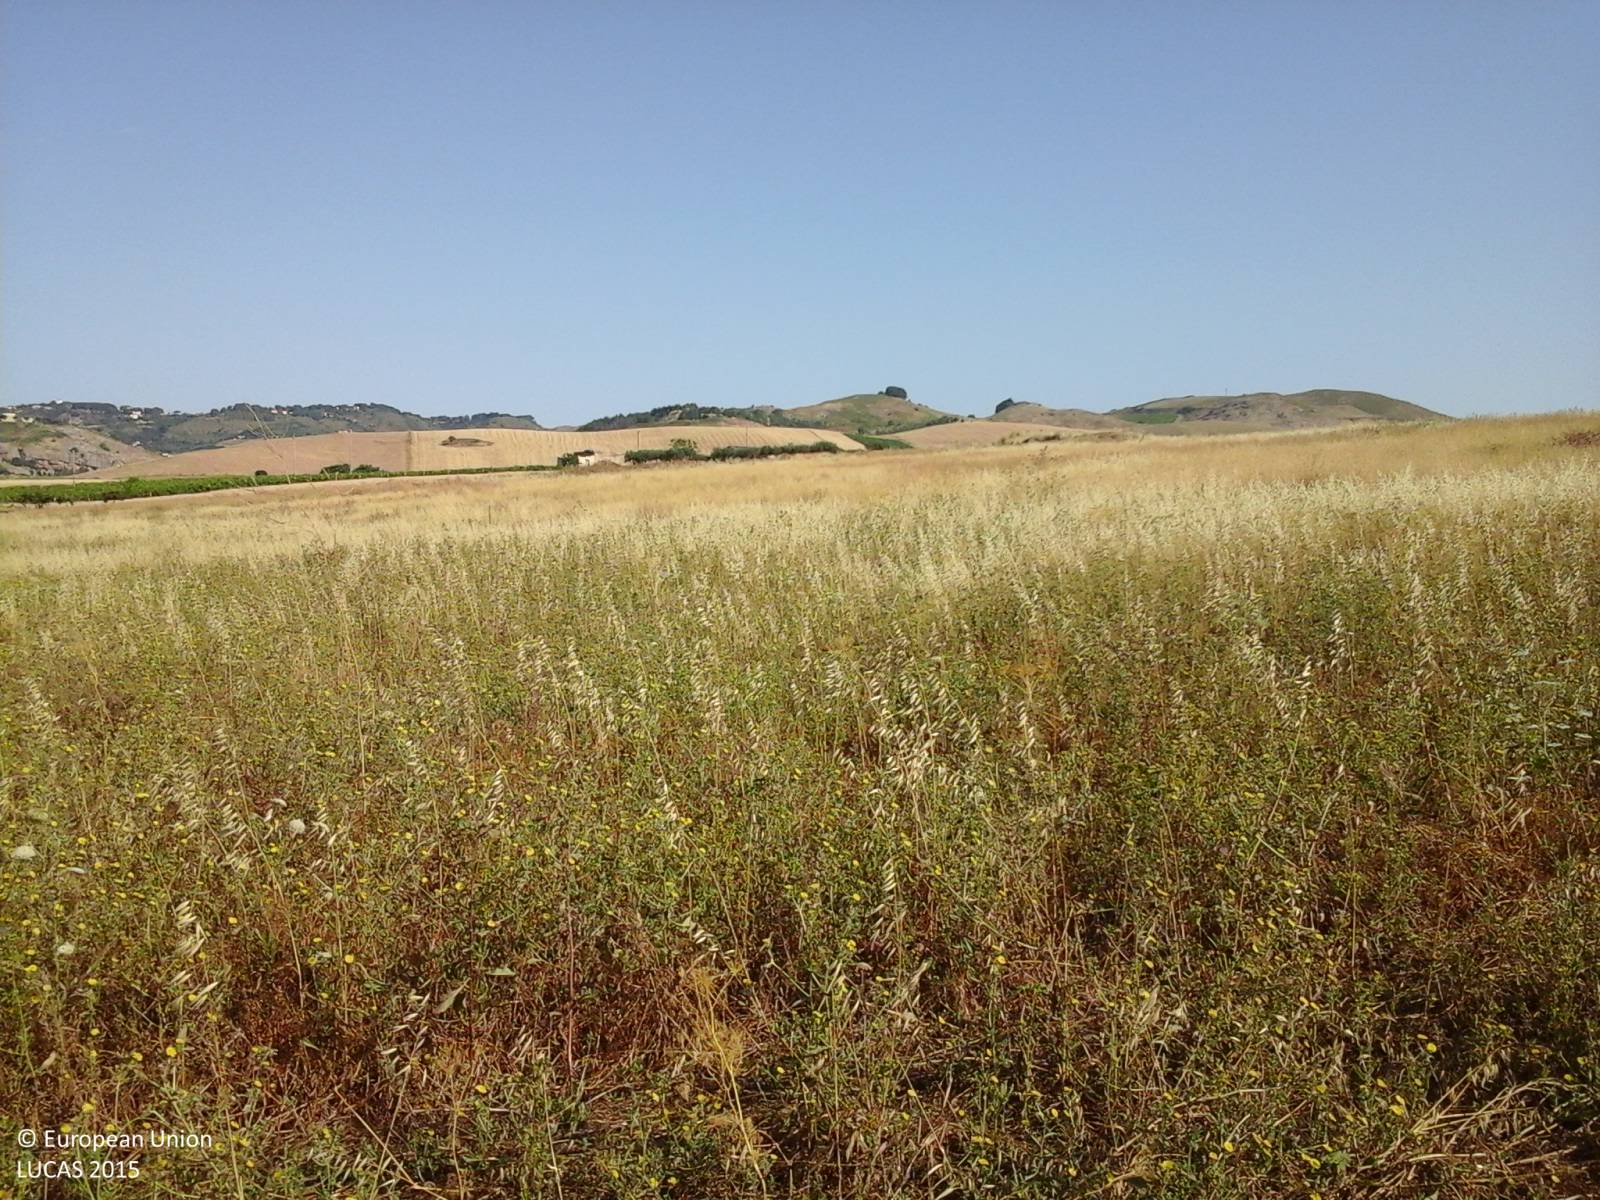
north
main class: Cropland
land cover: Vineyards
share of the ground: 50 - 75 %
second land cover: Other bare soil
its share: > 75 %
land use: Agriculture (excluding fallow land and kitchen gardens)
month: June
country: IT
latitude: 37.8144
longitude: 12.8302
